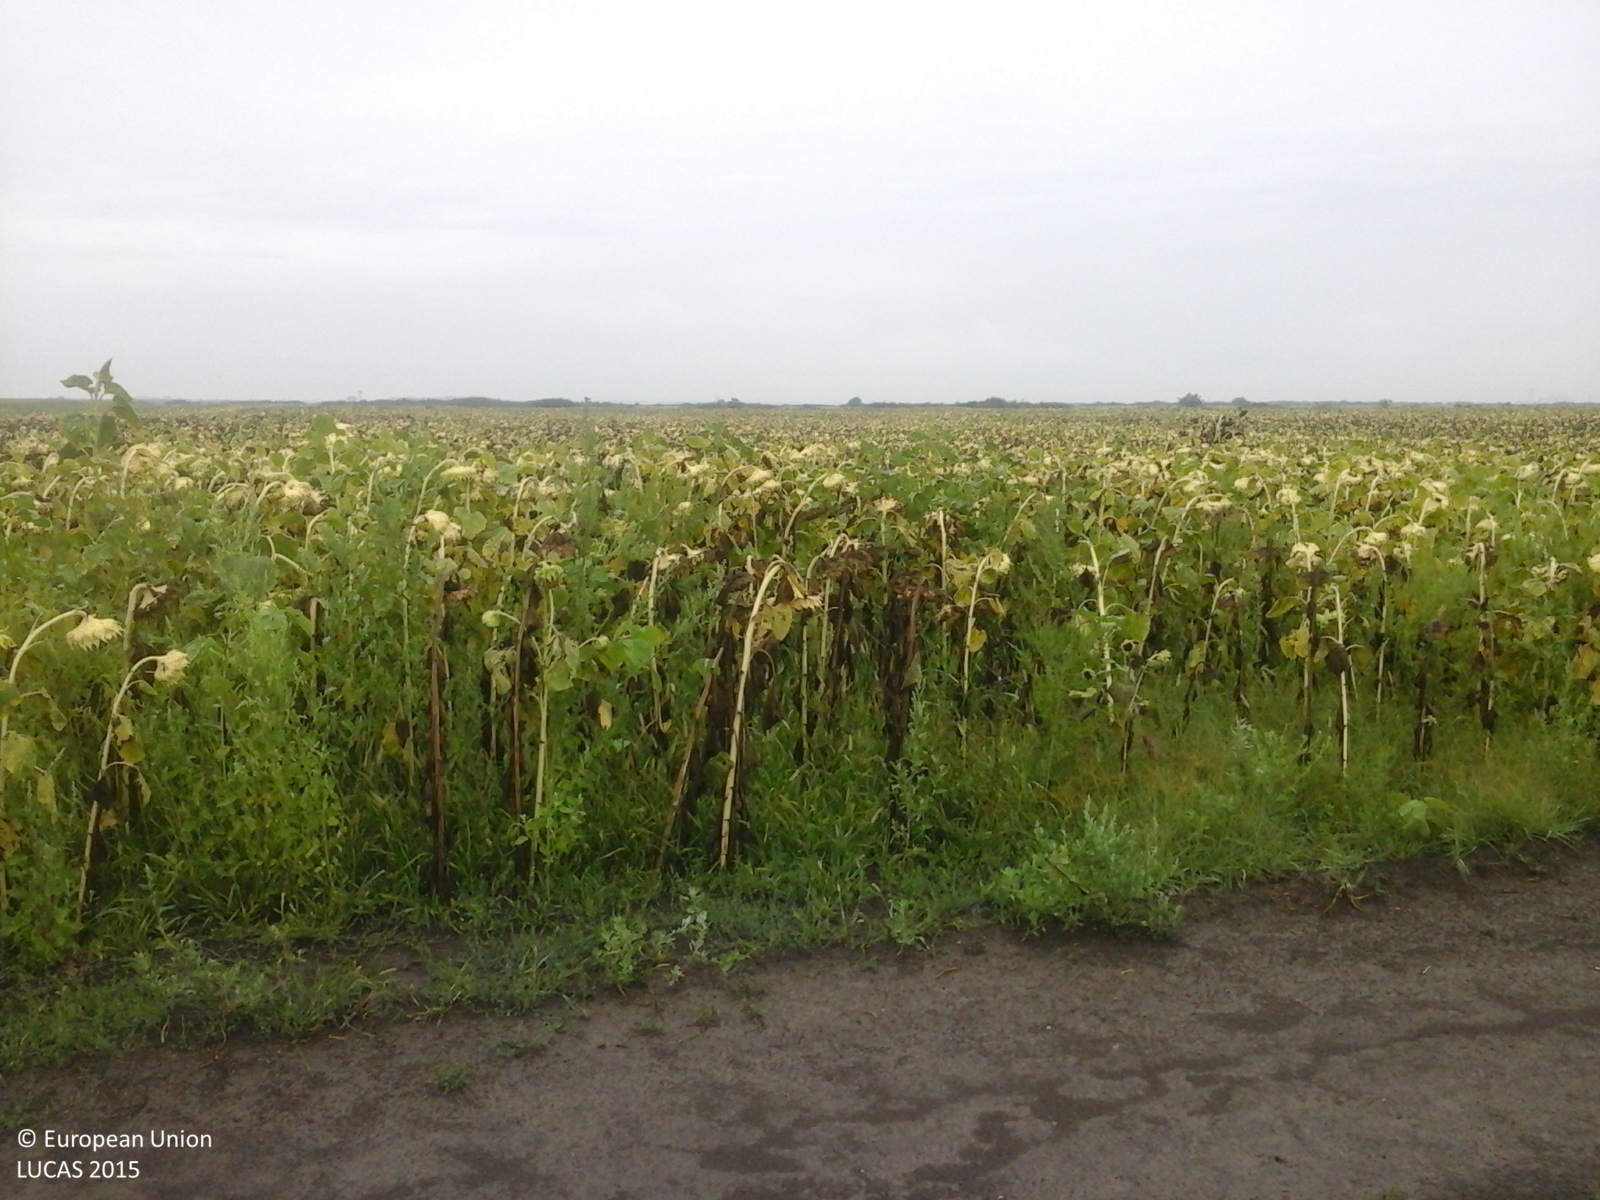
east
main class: Cropland
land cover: Sunflower
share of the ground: > 75 %
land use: Agriculture (excluding fallow land and kitchen gardens)
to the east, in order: Sunflower; Tracks; Abandoned hedges; Ditches and canals; Abandoned hedges; Sunflower
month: August
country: RO
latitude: 45.6060
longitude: 21.1193
